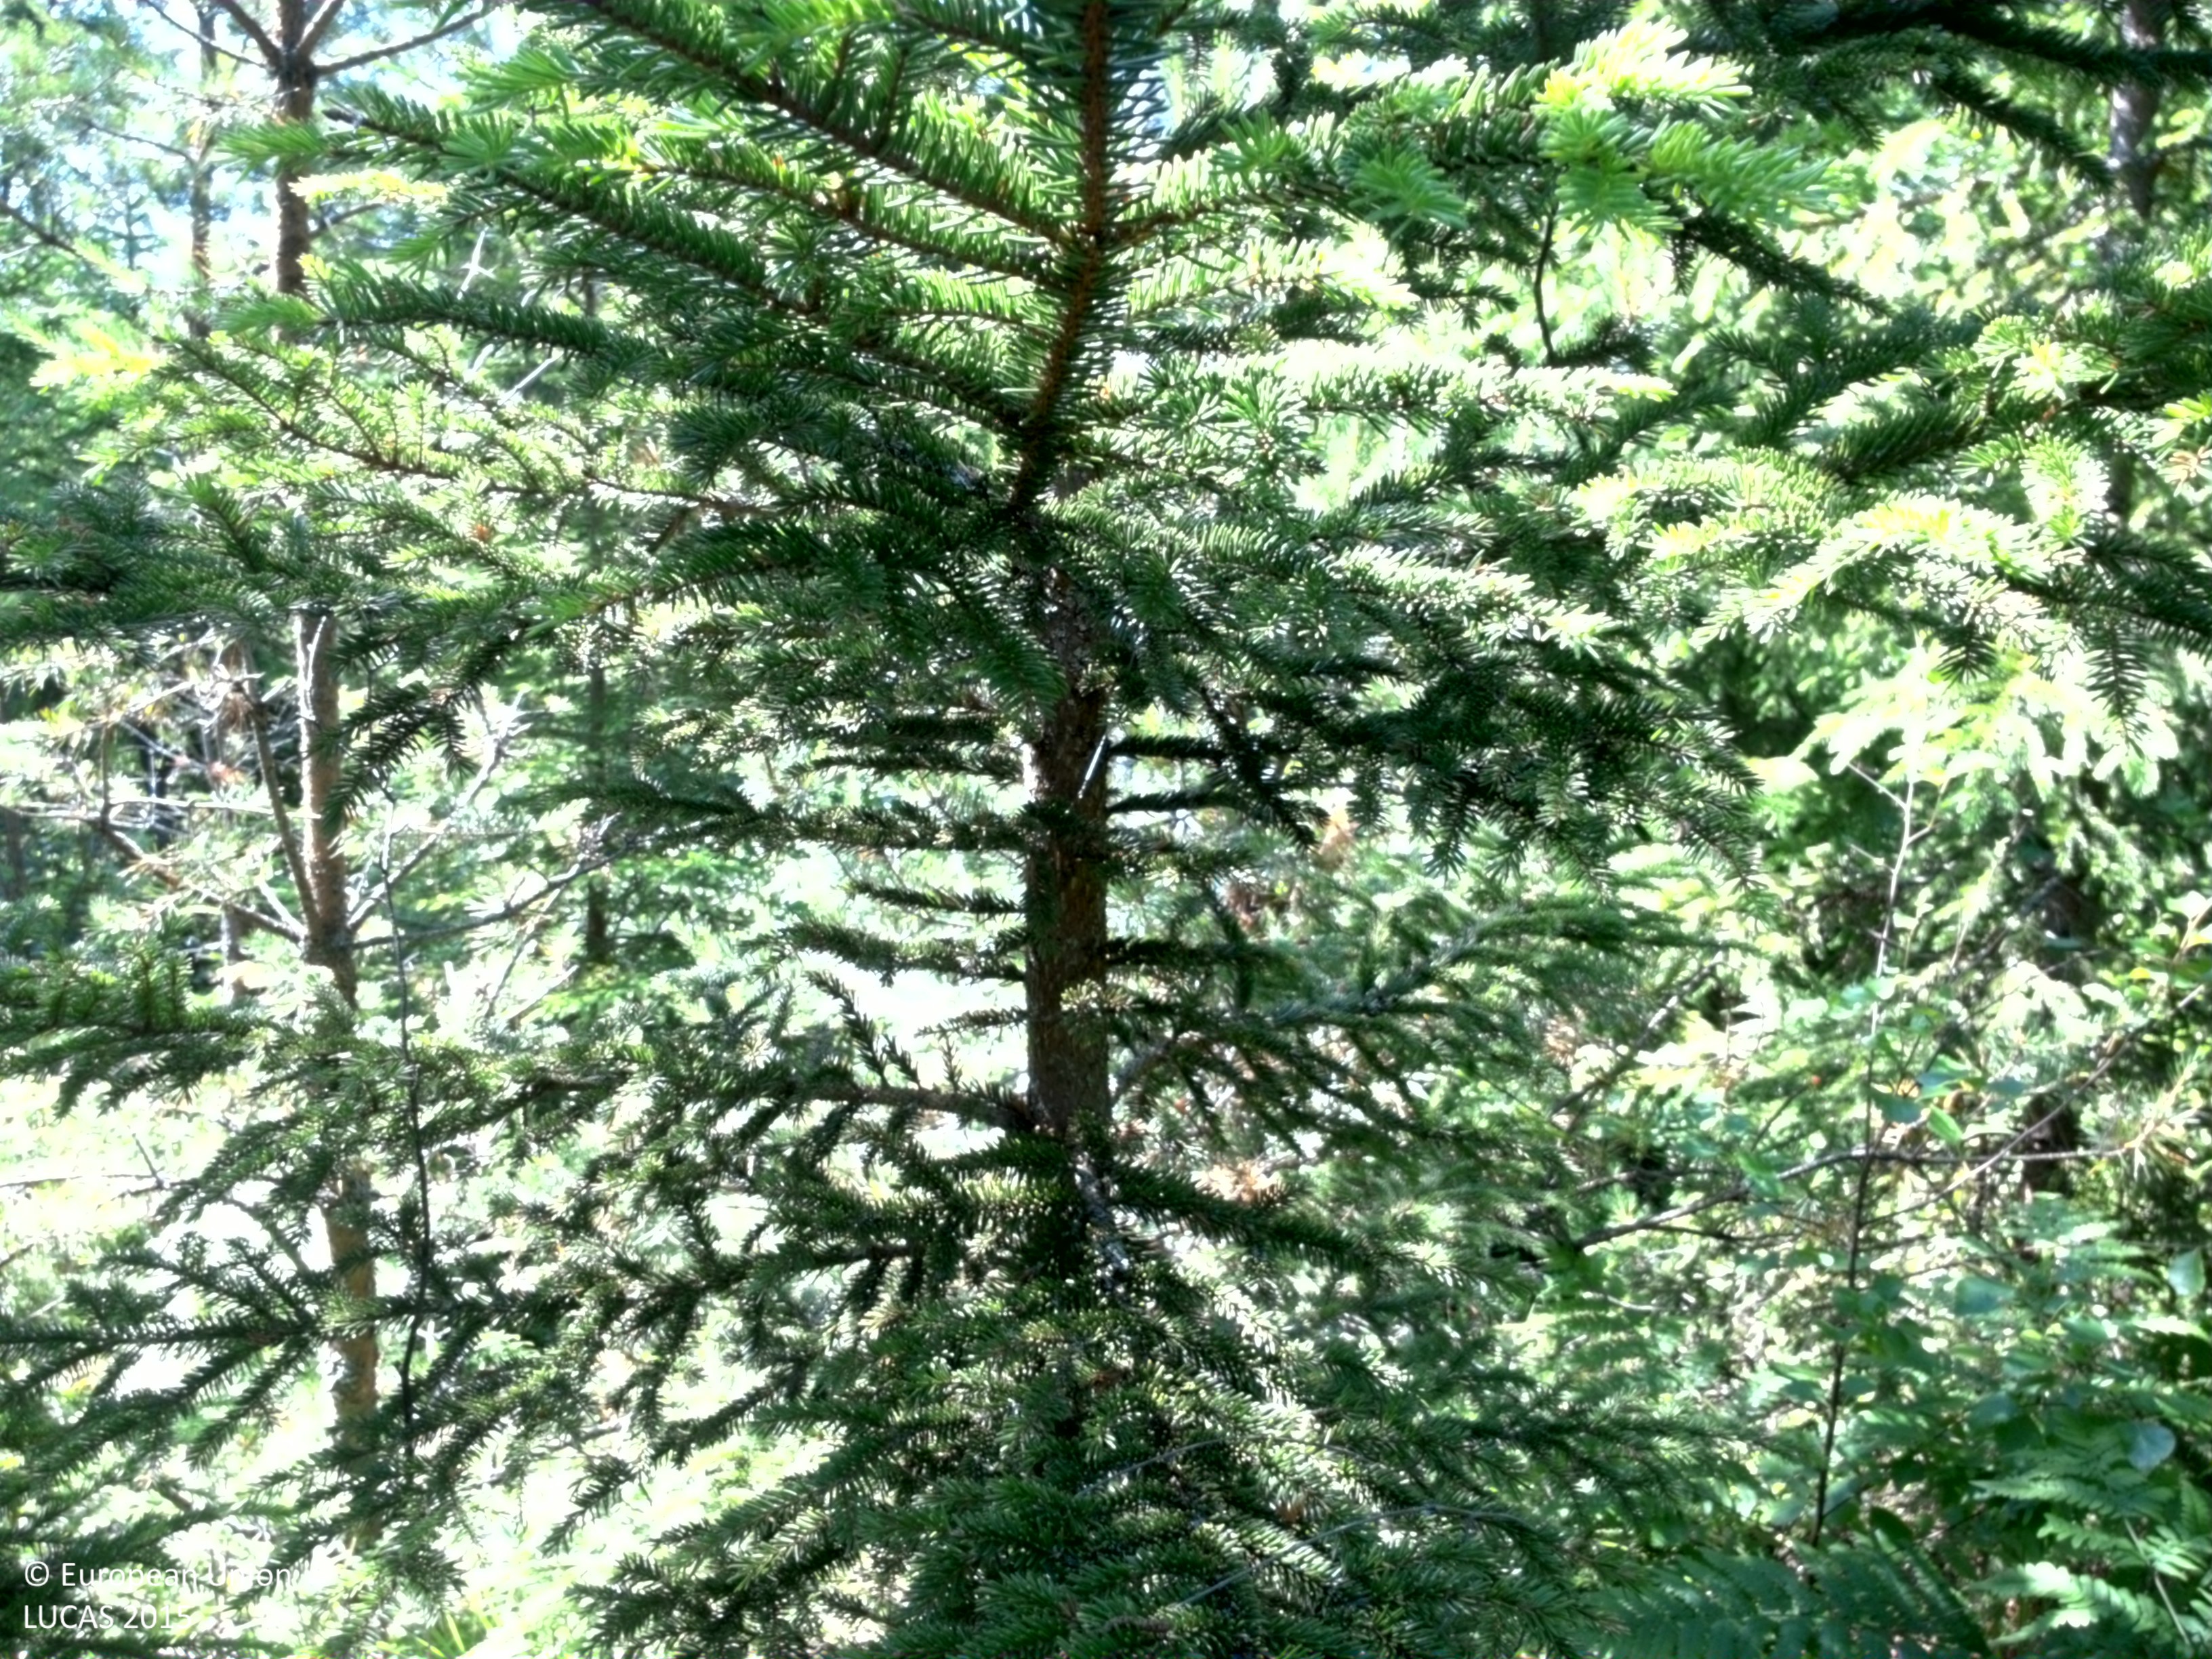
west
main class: Woodland
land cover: Spruce dominated mixed woodland
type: boreal forest
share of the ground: > 75 %
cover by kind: coniferous forest trees 50 %, broadleaved forest trees 30 %, herbaceous plants 15 %, shrubs 5 %
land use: Forestry
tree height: < 5 m
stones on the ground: < 10 %
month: July
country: SE
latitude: 59.1157
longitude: 14.5506
